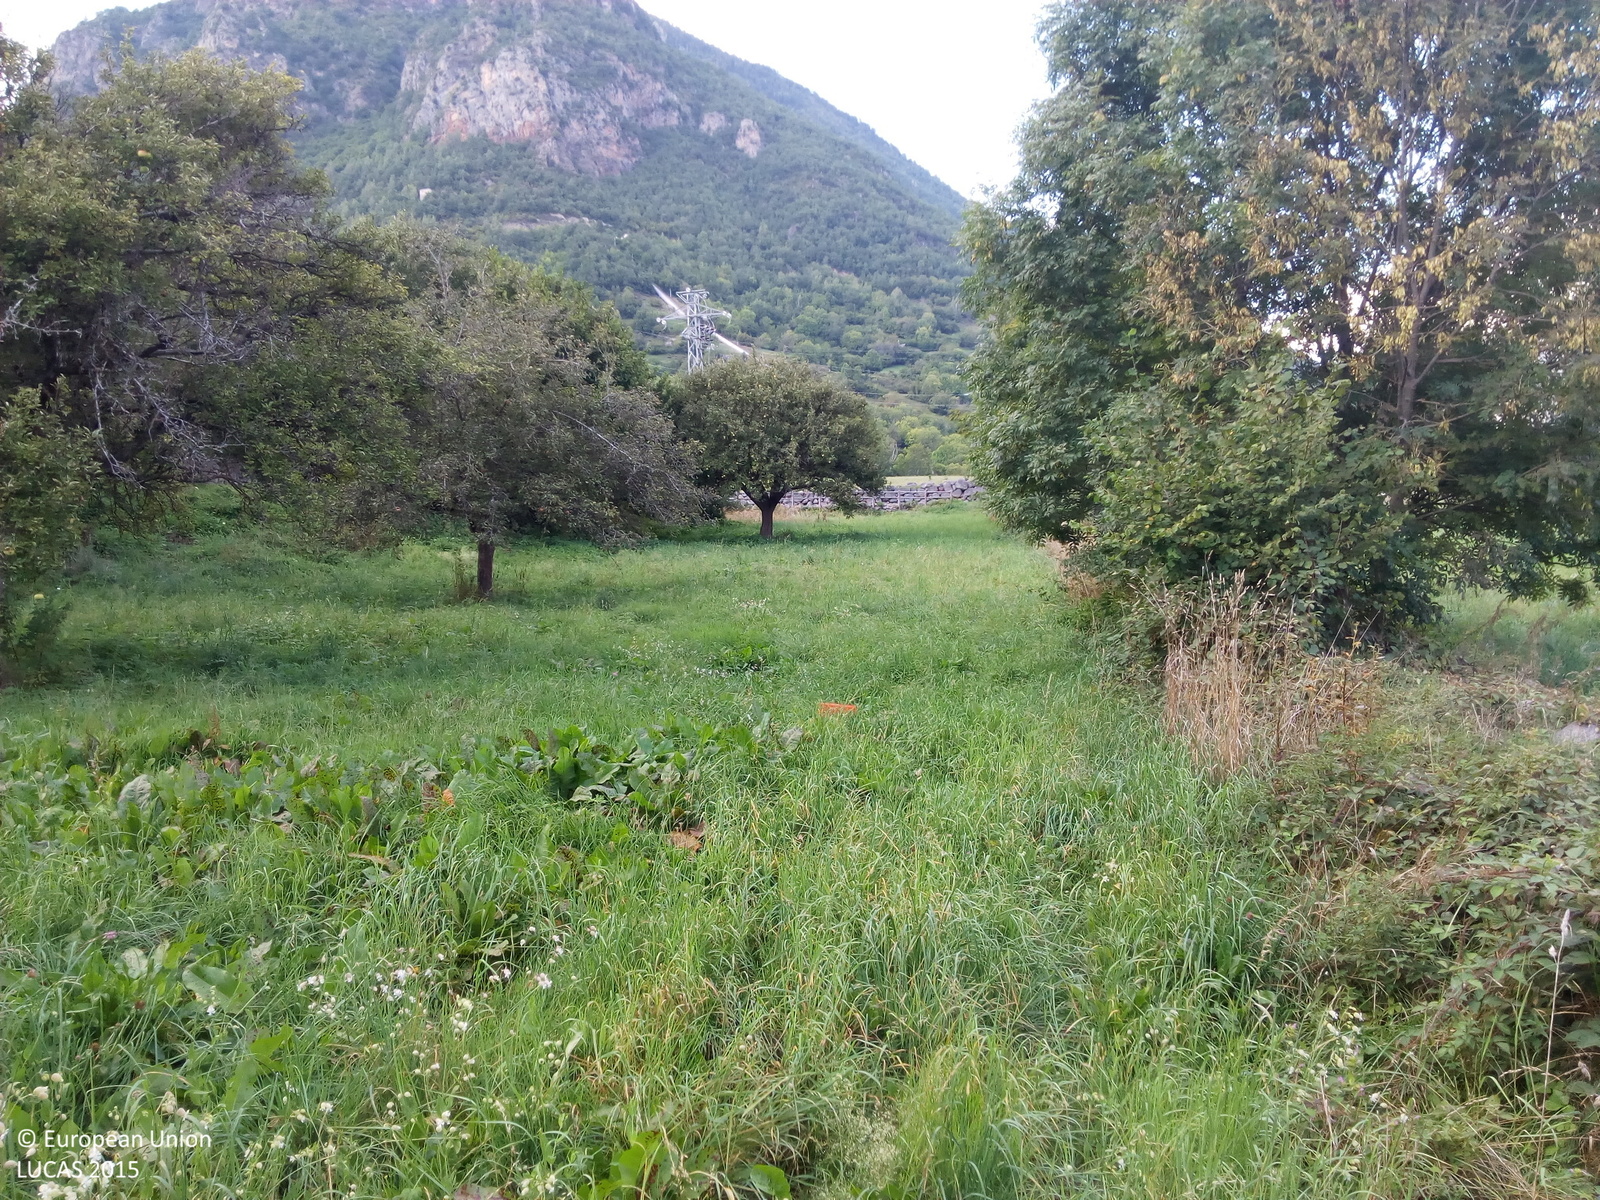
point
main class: Cropland
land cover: Apple fruit
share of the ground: > 75 %
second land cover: Spontaneously vegetated surfaces
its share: > 75 %
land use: Agriculture (excluding fallow land and kitchen gardens)
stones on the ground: < 10 %
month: September
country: ES
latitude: 42.5870
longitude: 0.4872
